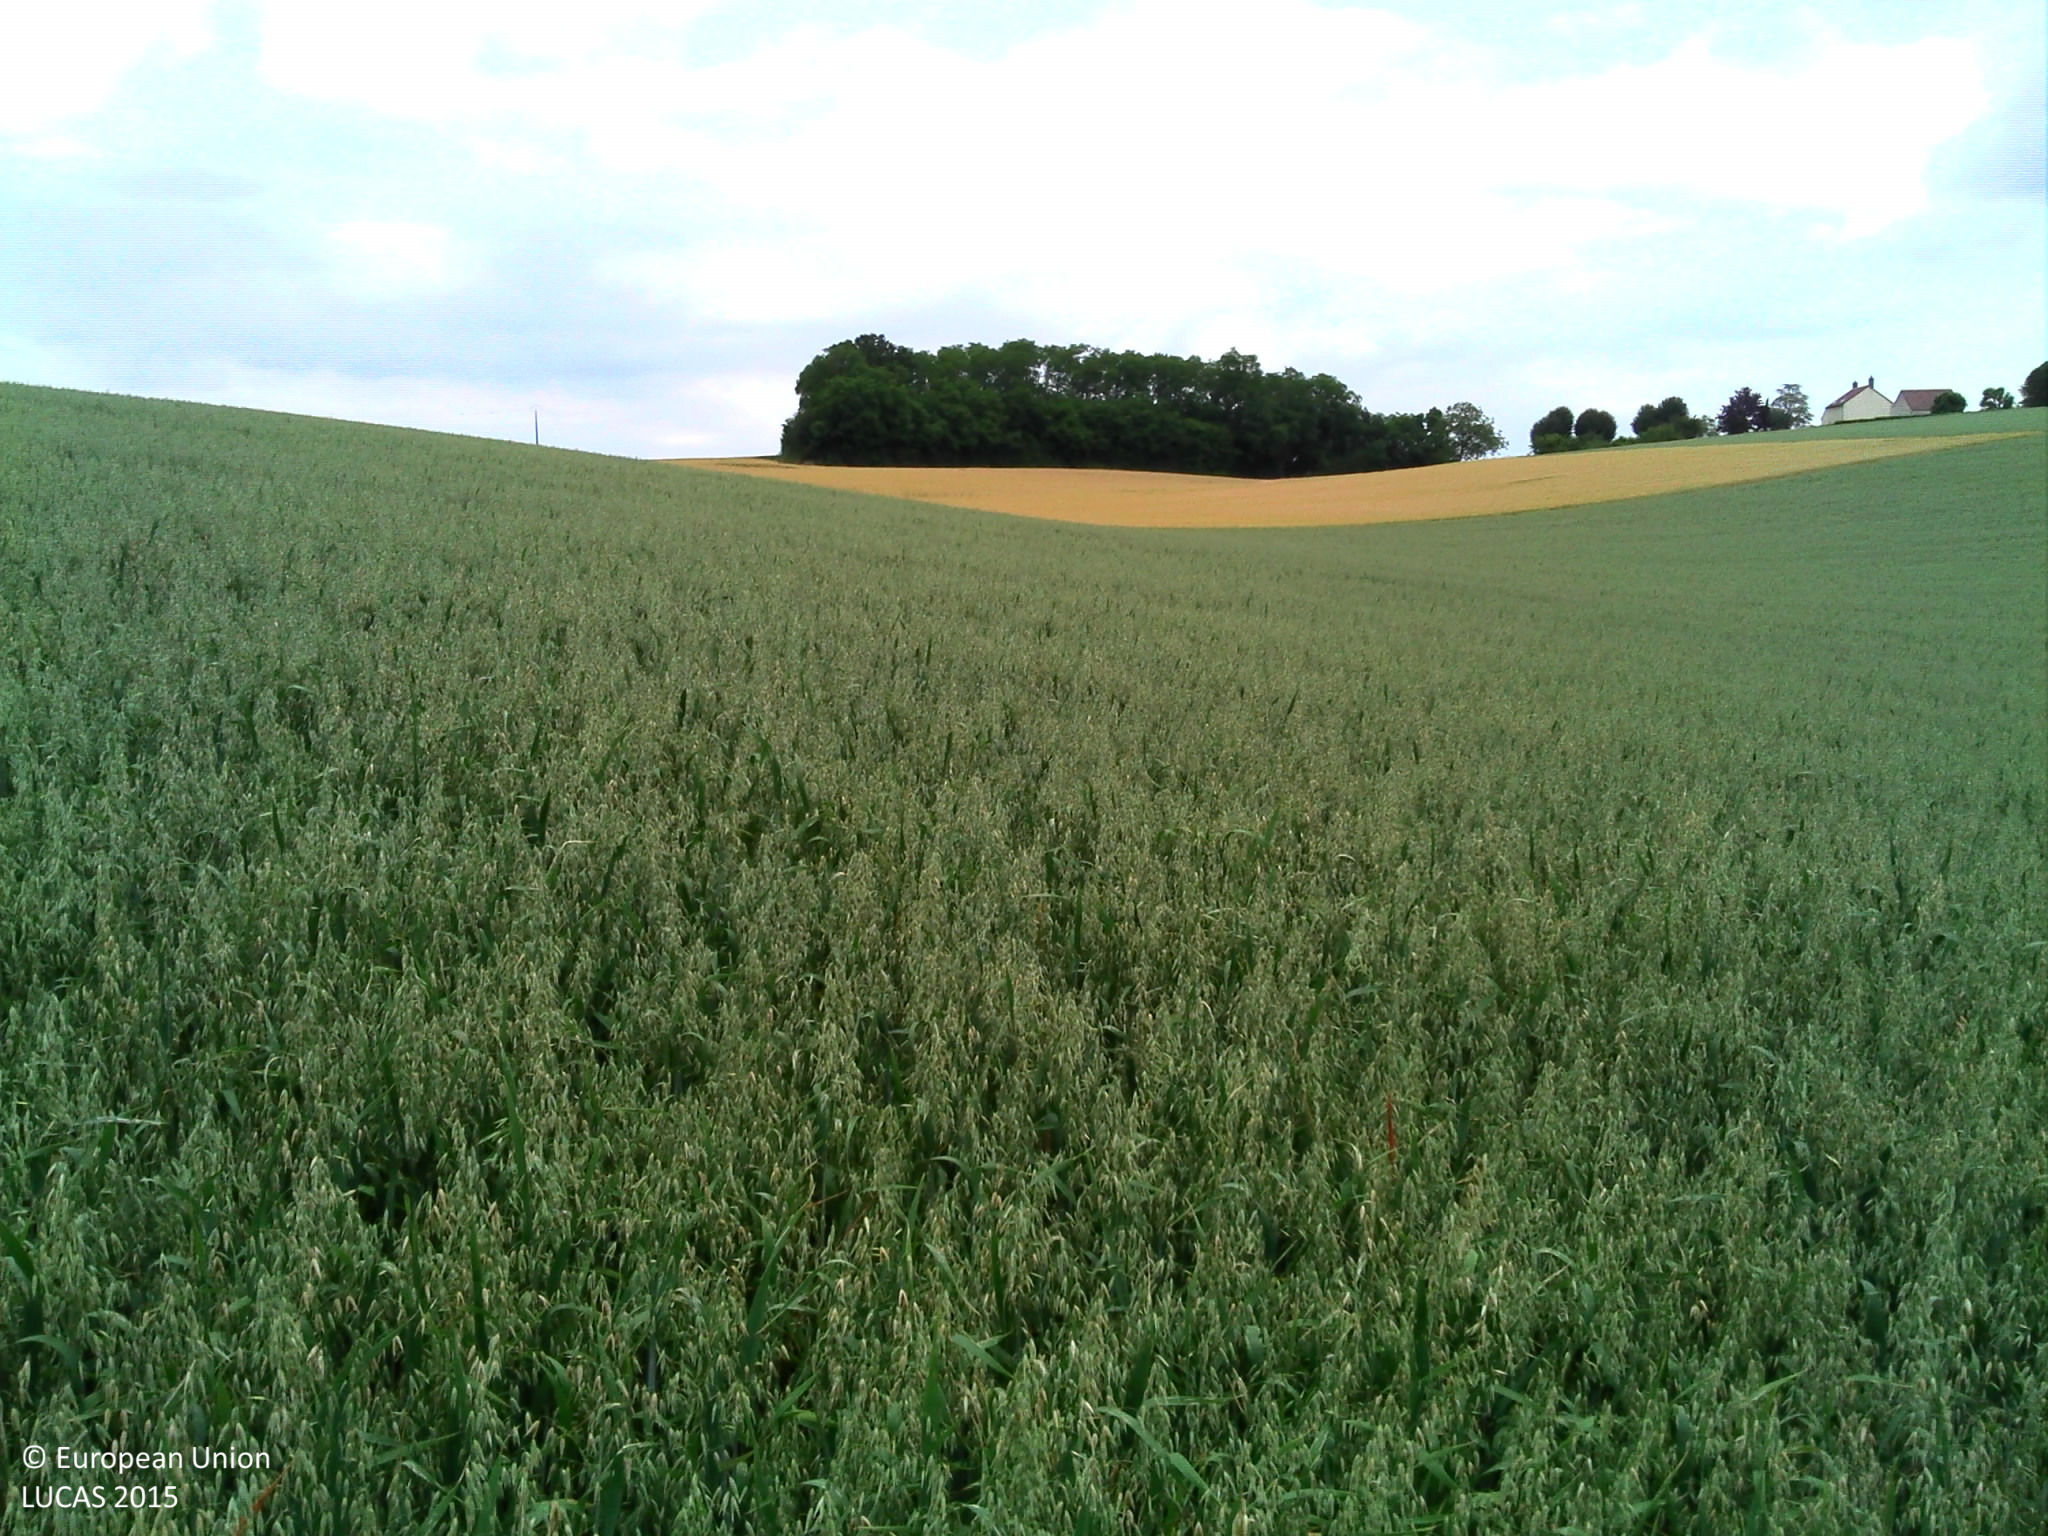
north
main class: Cropland
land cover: Oats
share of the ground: > 75 %
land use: Agriculture (excluding fallow land and kitchen gardens)
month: June
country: FR
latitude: 47.3781
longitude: 3.1477
